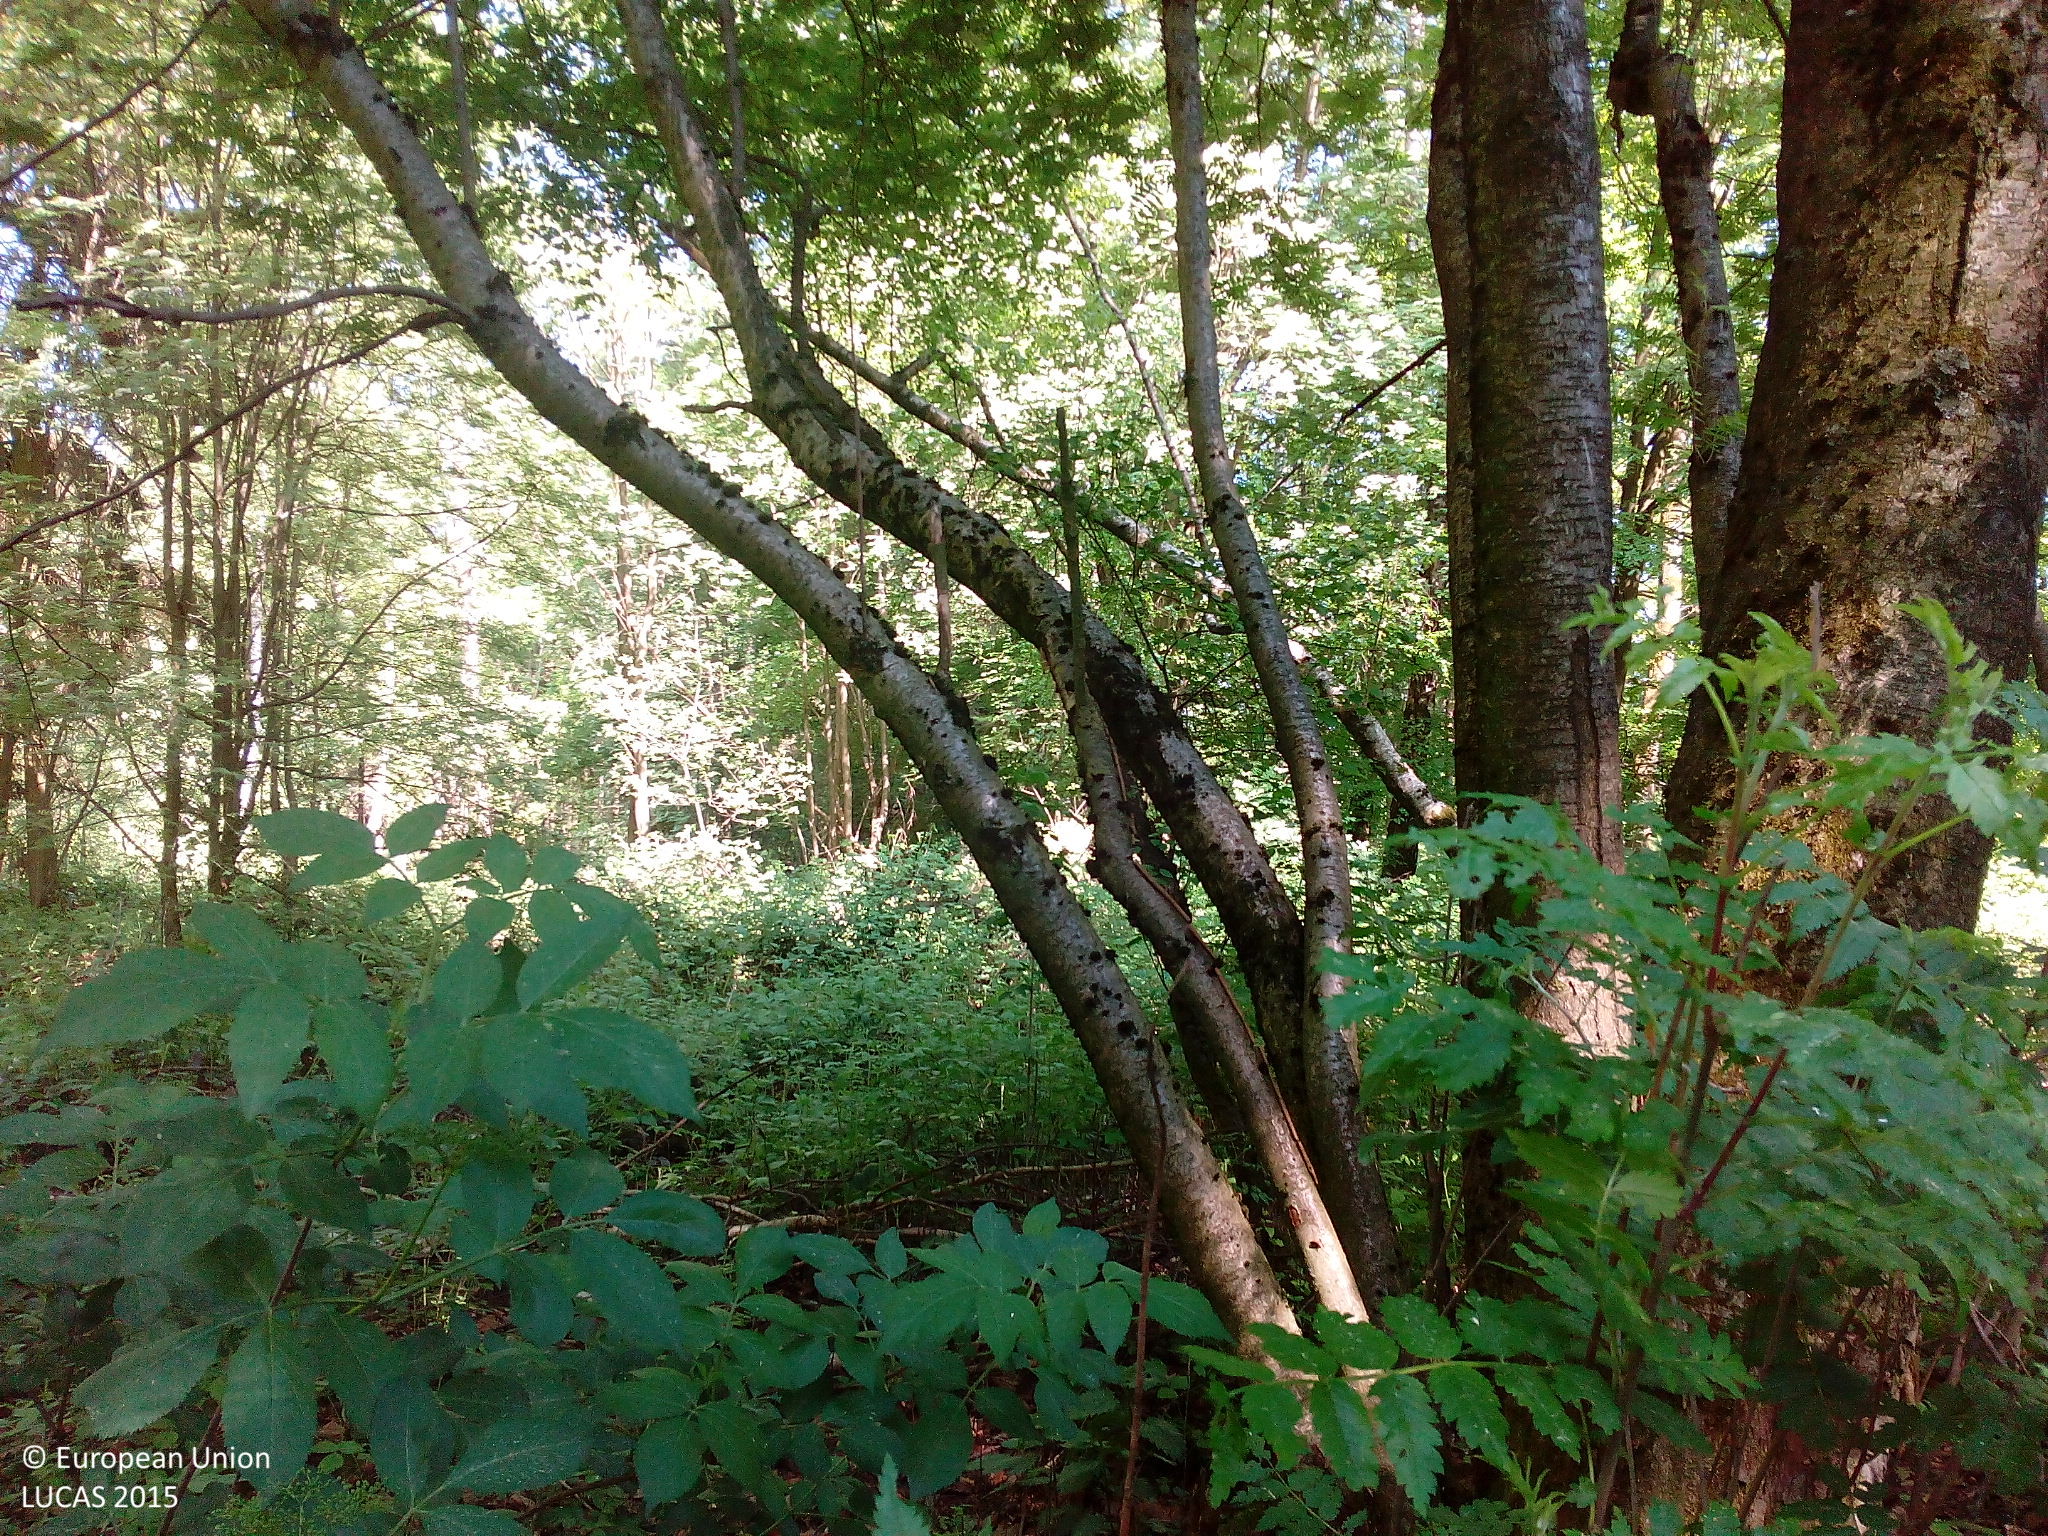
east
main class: Woodland
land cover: Broadleaved woodland
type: mesophytic deciduous forest
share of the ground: > 75 %
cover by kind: broadleaved forest trees 90 %, coniferous forest trees 5 %, shrubs 5 %
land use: Forestry
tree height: > 5 m
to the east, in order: Broadleaved woodland; Tracks; Grass margins; Triticale
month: May
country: DE
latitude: 49.4196
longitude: 11.4470
